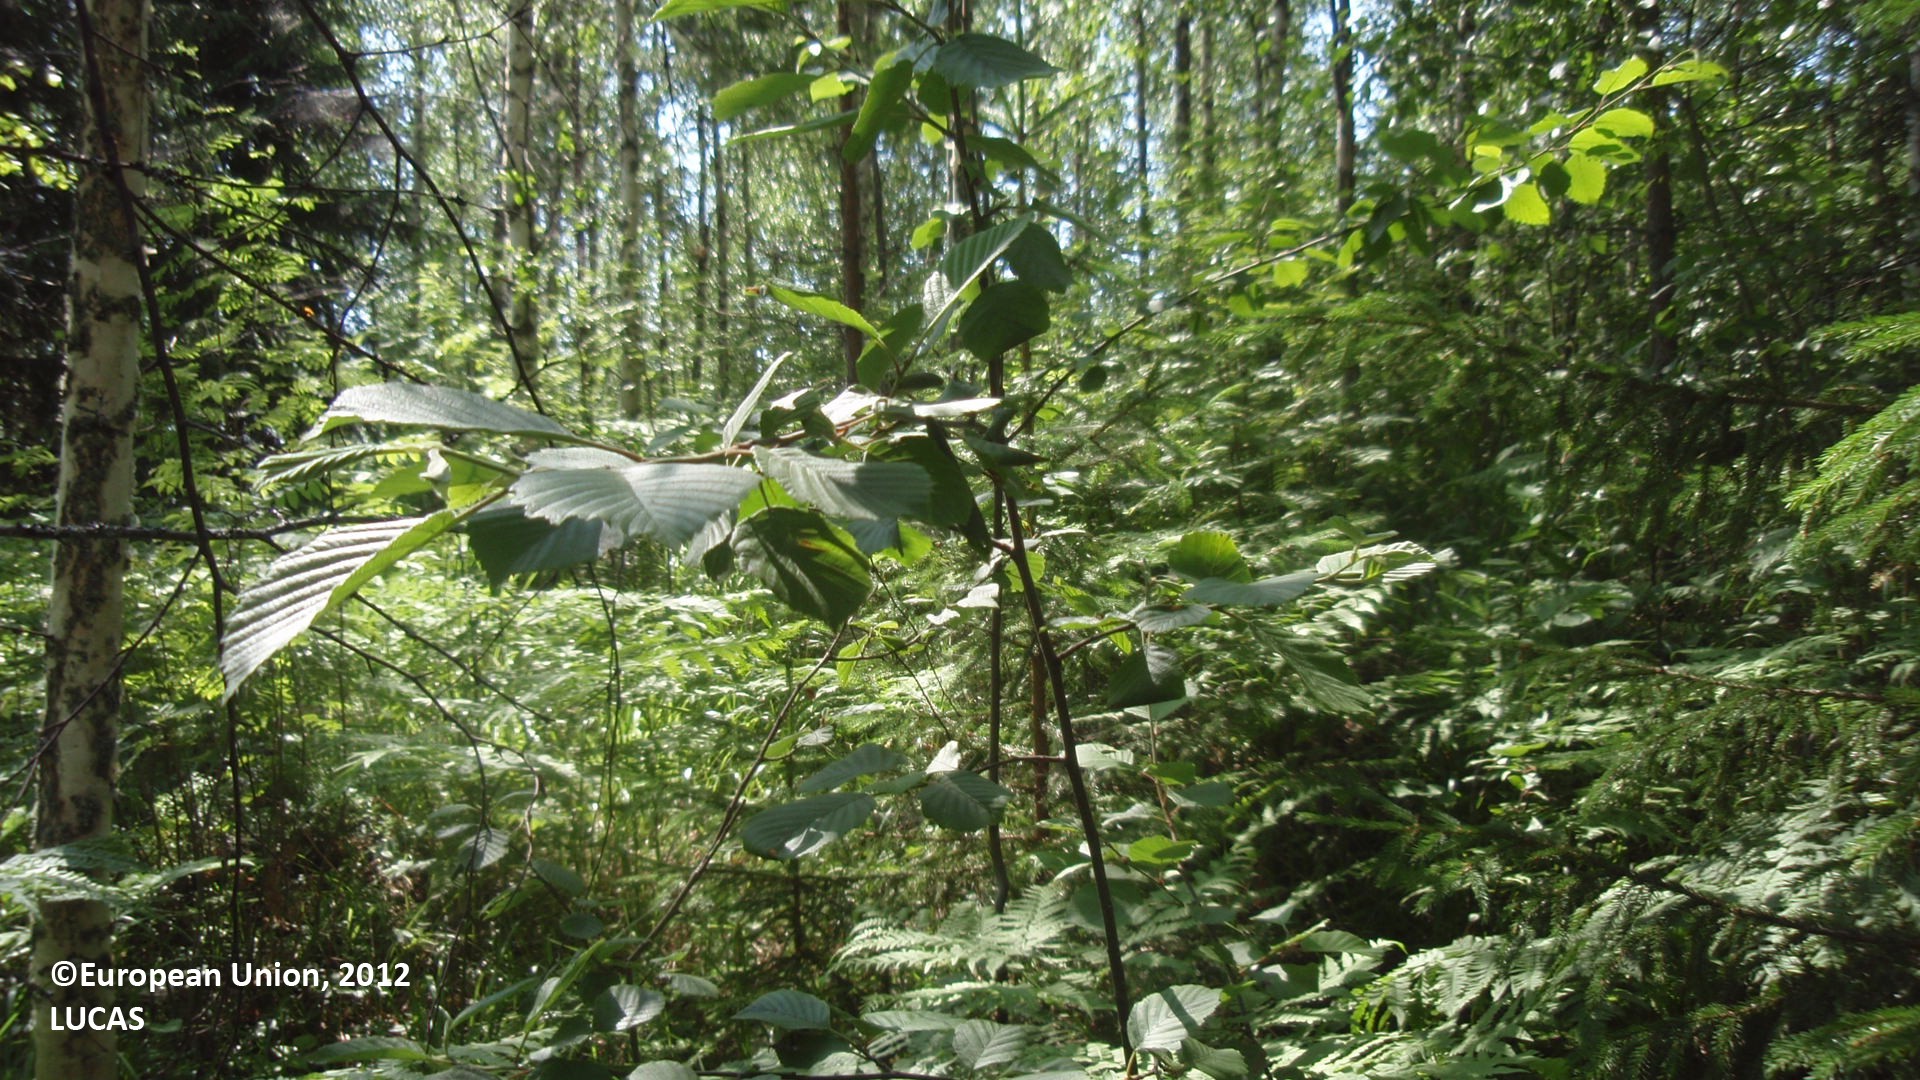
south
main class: Woodland
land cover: Broadleaved woodland
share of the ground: 50 - 75 %
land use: Forestry
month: July
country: FI
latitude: 61.5845
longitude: 29.1684
